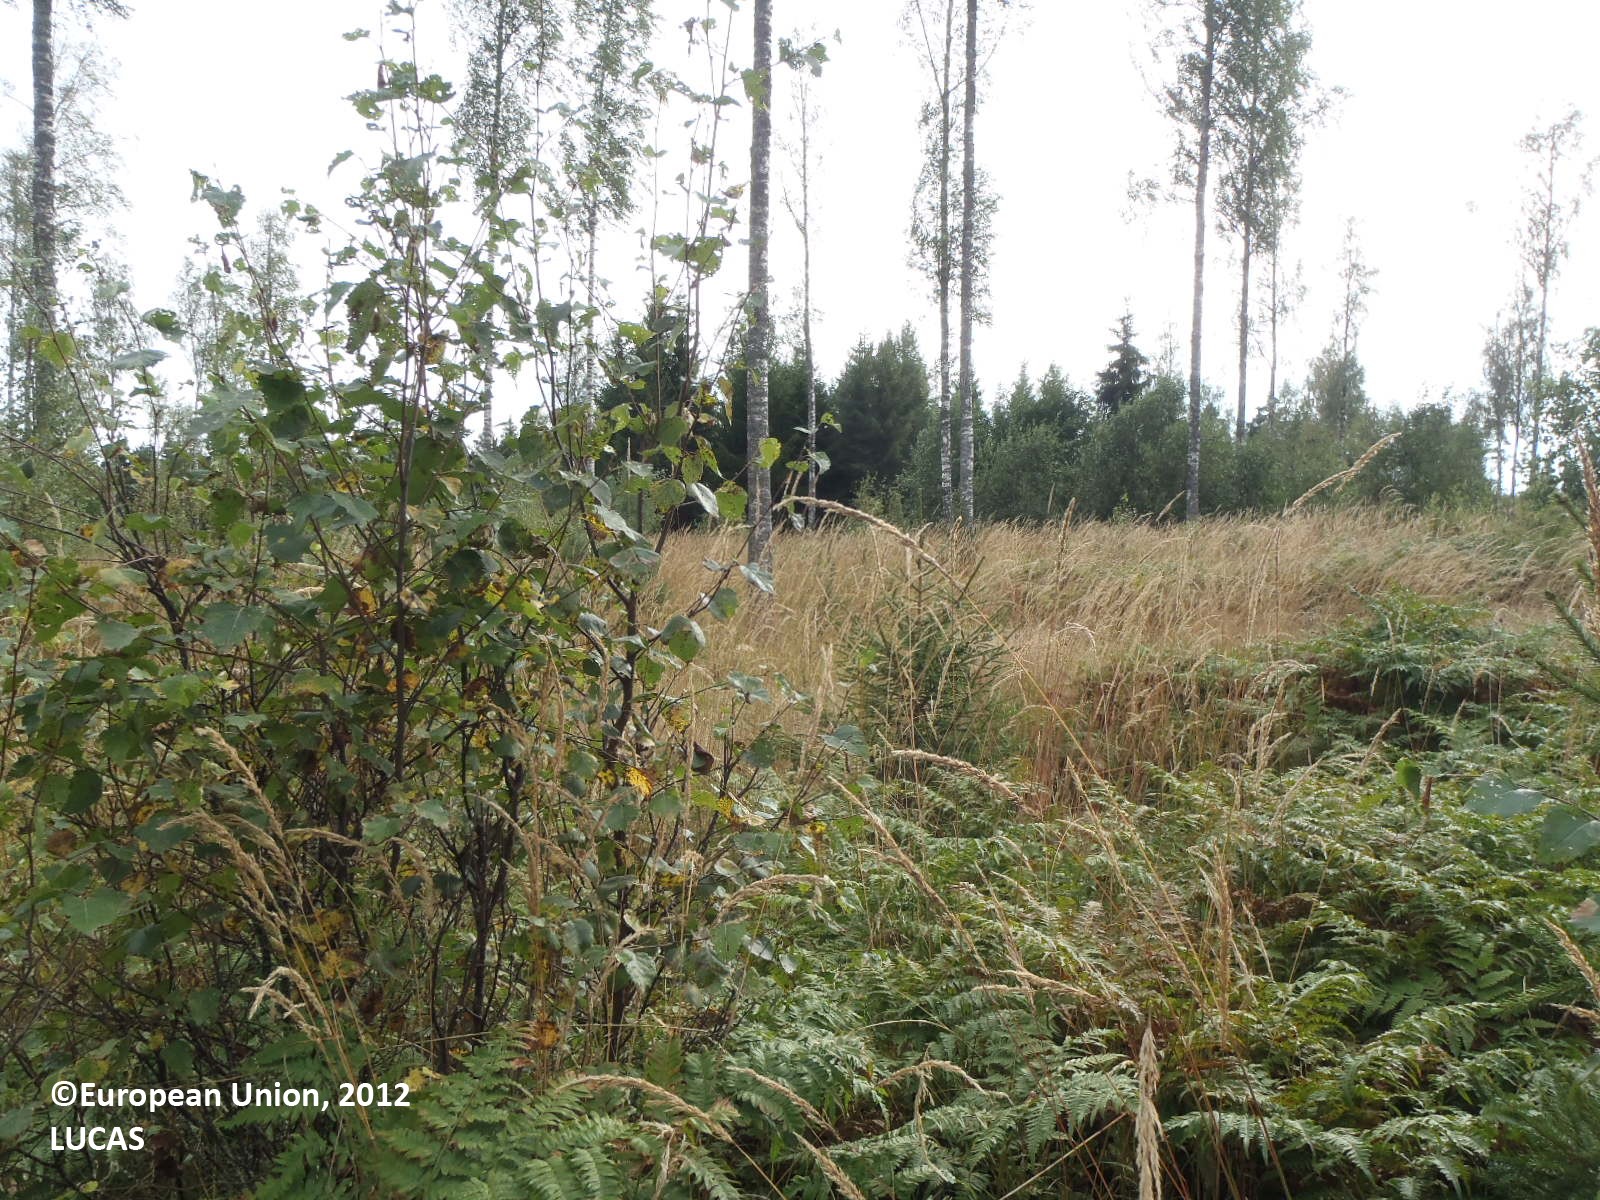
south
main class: Woodland
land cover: Other mixed woodland
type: boreal forest
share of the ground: 25 - 50 %
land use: Forestry
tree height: > 5 m
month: August
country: FI
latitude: 60.7728
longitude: 22.4981
